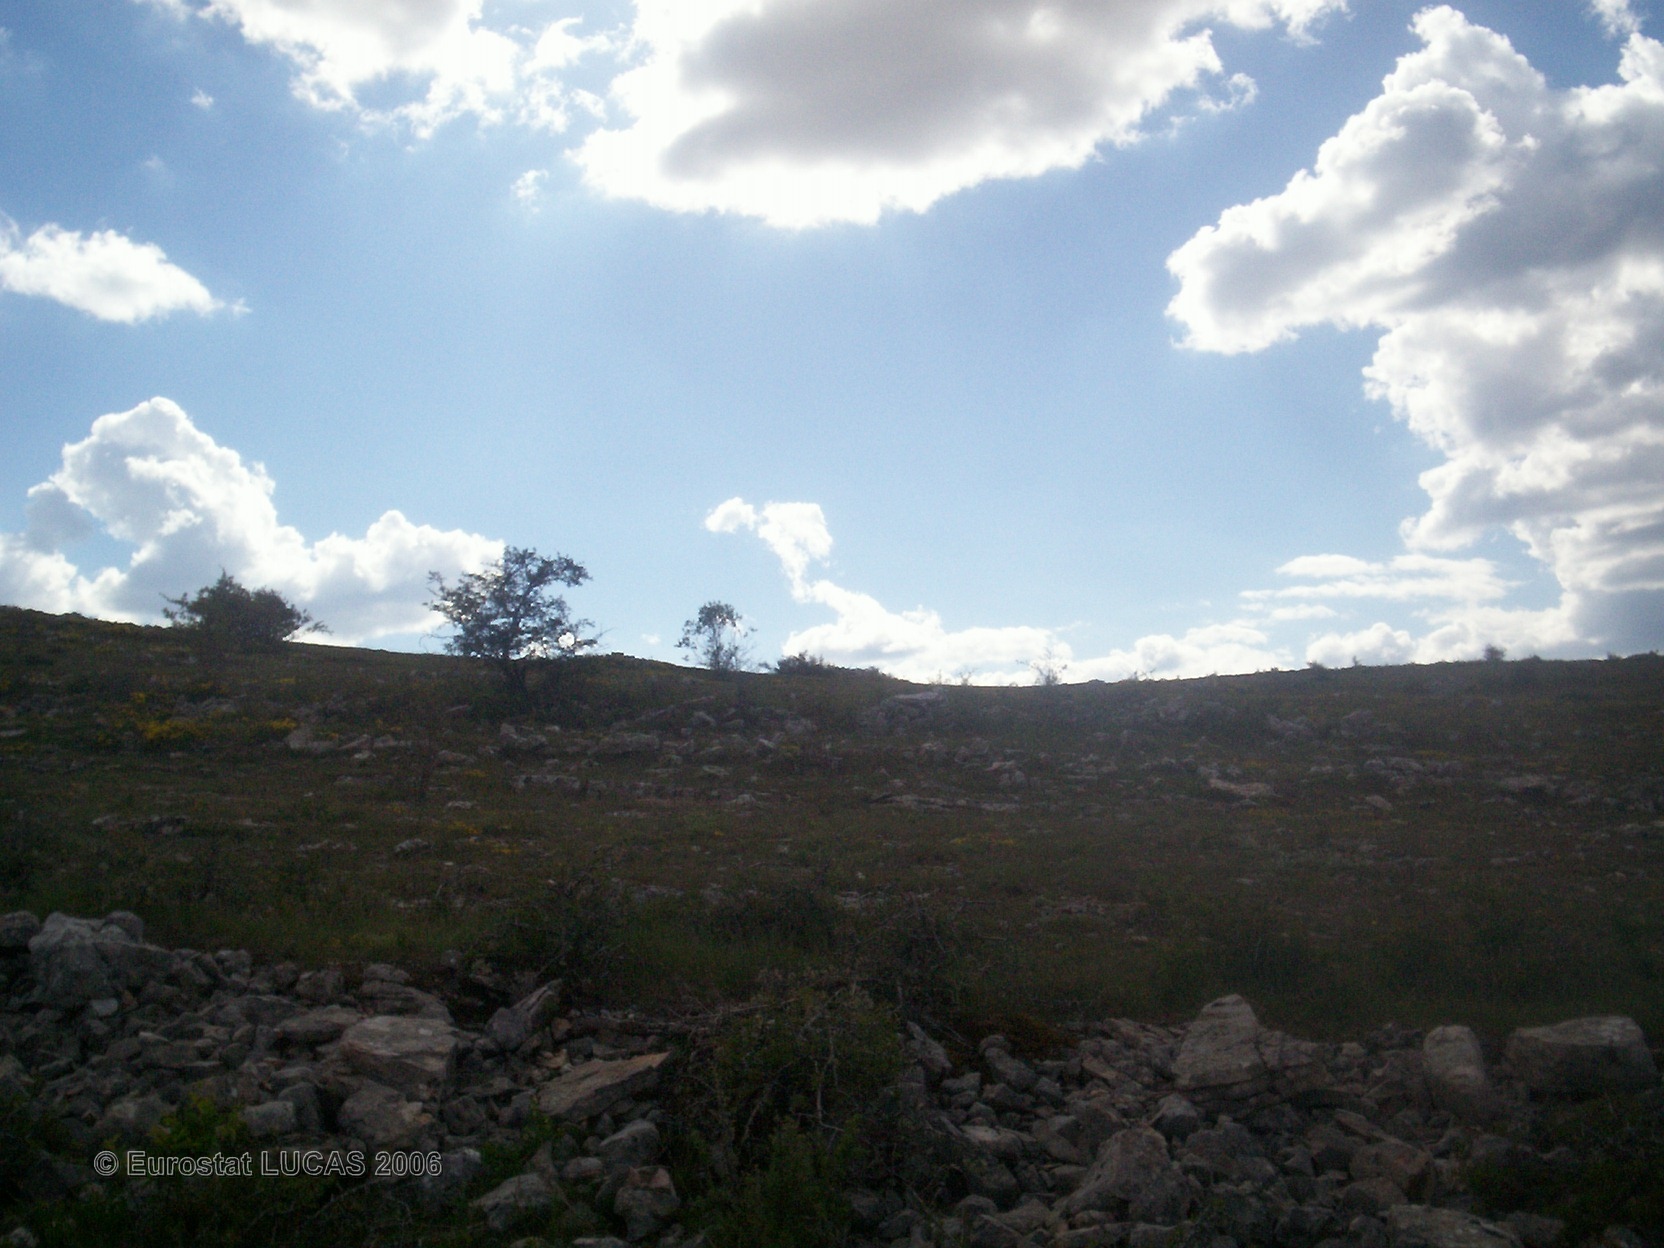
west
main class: Grassland
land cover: Grassland without tree/shrub cover
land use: Agriculture (excluding fallow land and kitchen gardens)
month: June
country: FR
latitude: 44.2525
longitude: 3.4560
